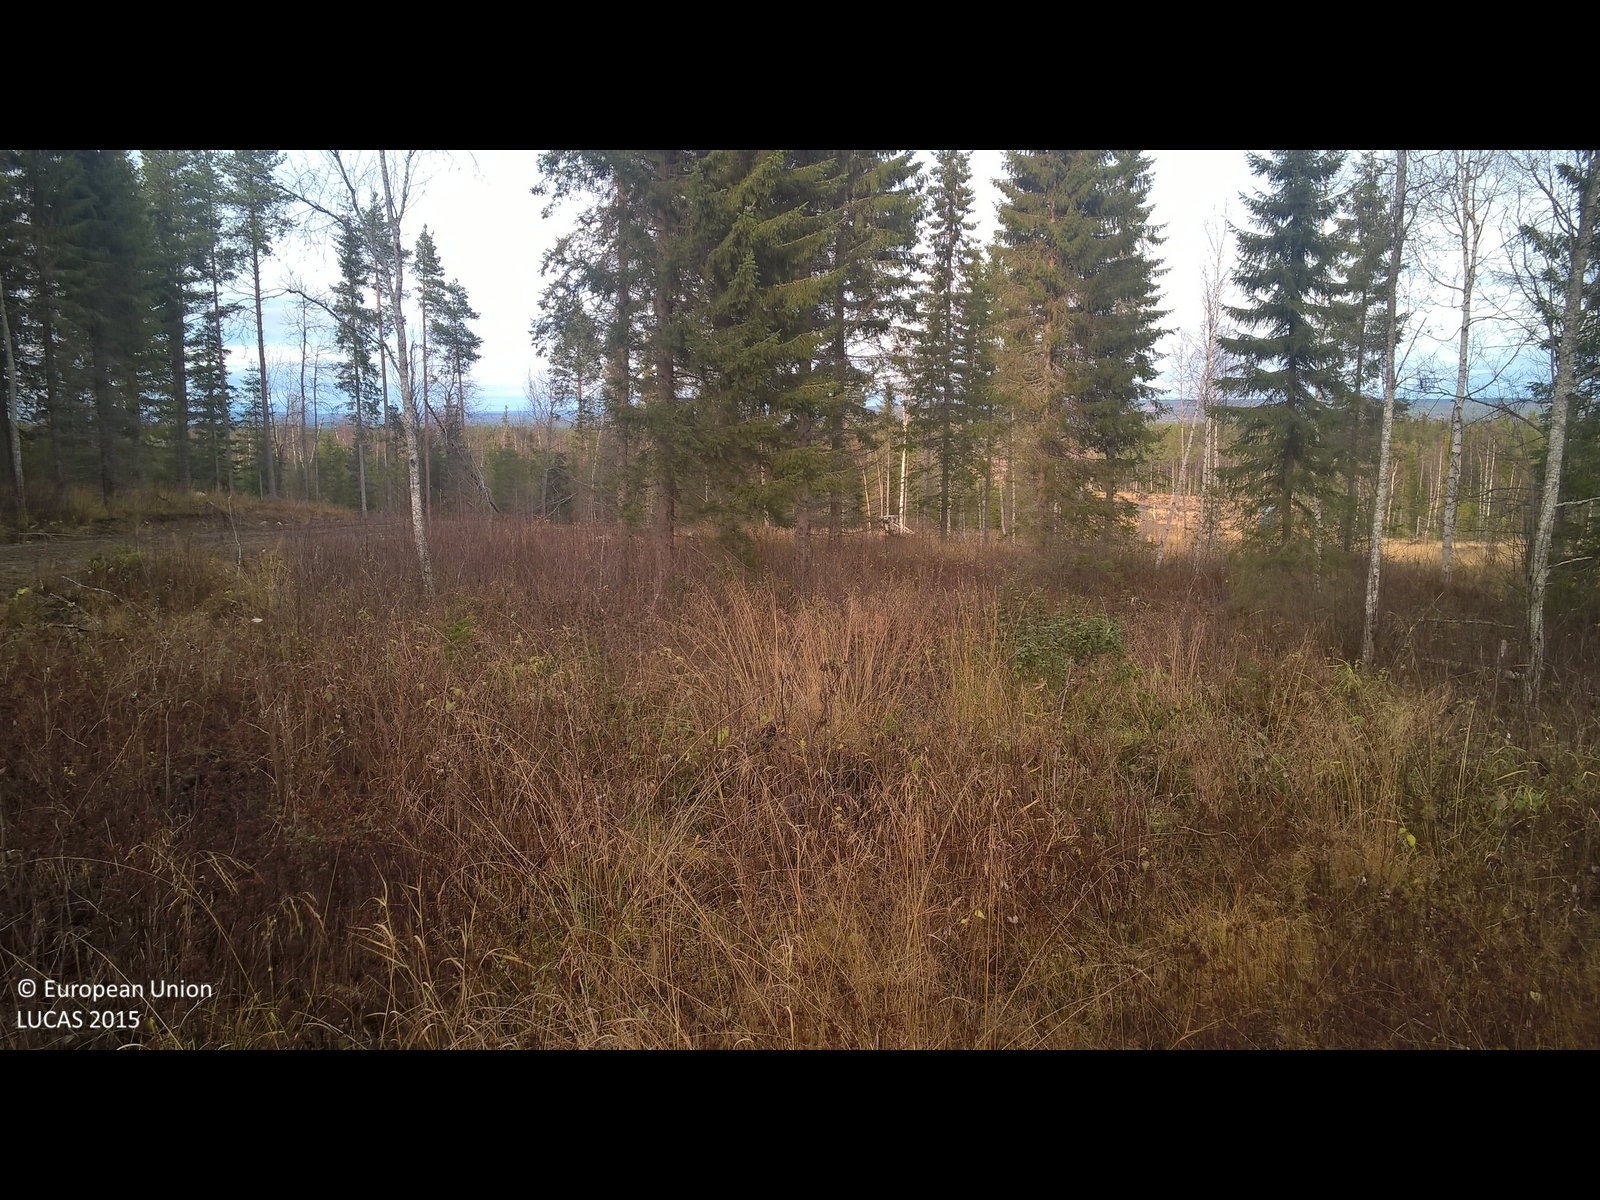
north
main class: Grassland
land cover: Spontaneously vegetated surfaces
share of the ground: > 75 %
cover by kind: herbaceous plants 100 %
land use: Forestry
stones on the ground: < 10 %
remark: Clear cut
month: October
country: SE
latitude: 63.2325
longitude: 15.0524
